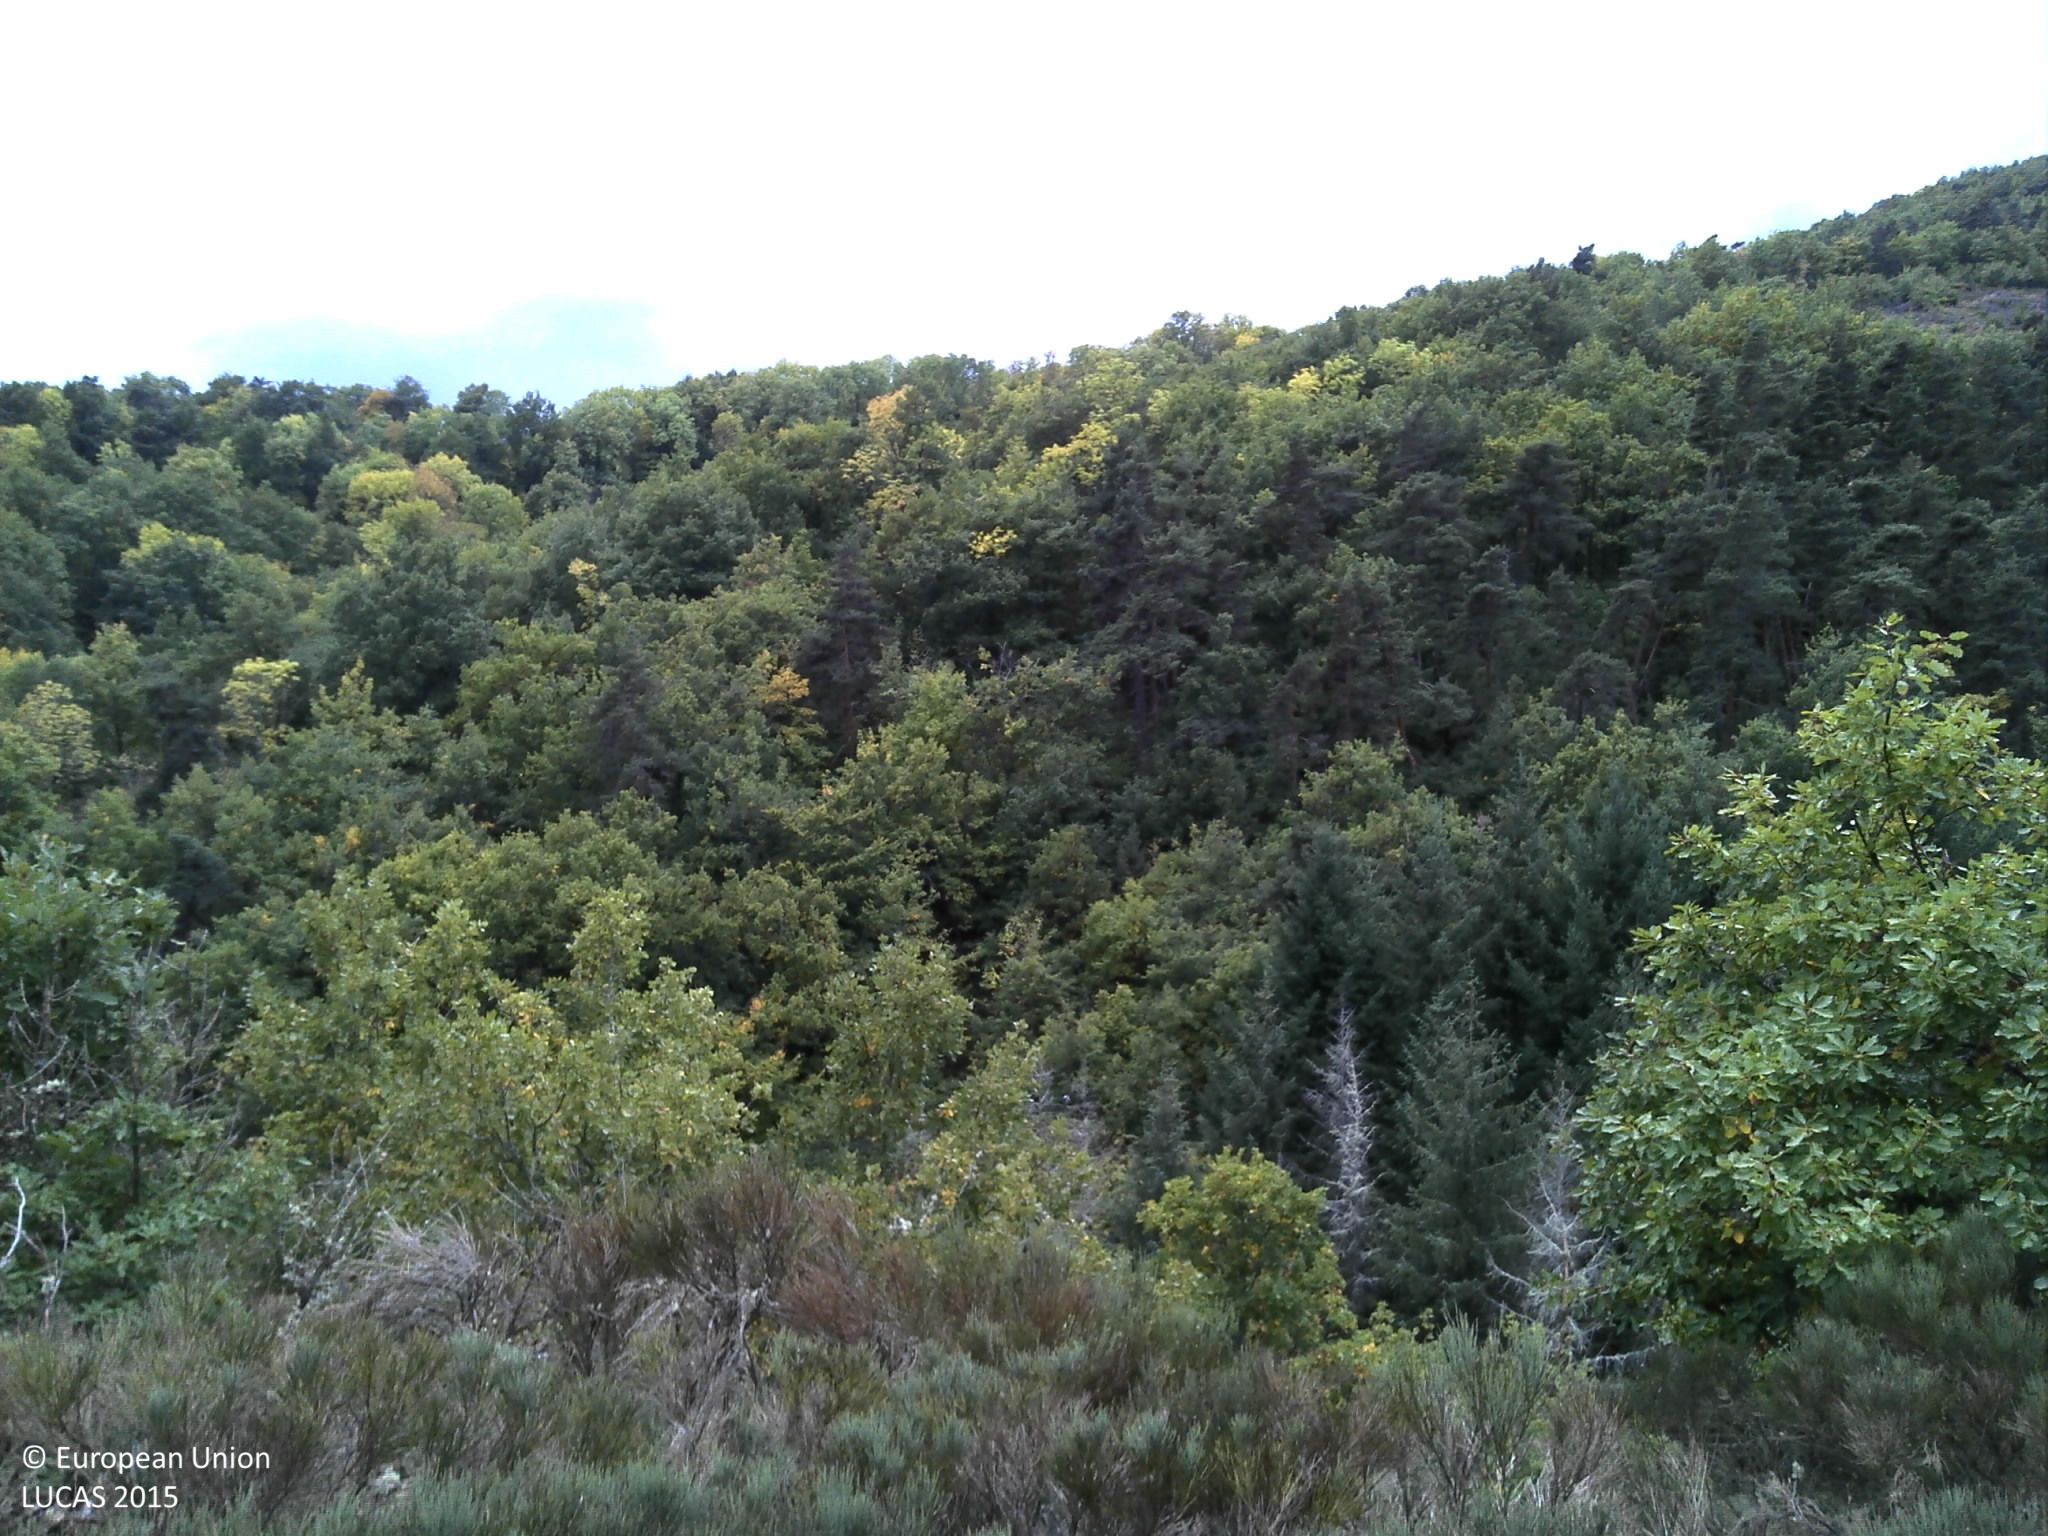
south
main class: Woodland
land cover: Pine dominated mixed woodland
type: alpine coniferous forest
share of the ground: > 75 %
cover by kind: coniferous forest trees 50 %, broadleaved forest trees 25 %, herbaceous plants 15 %, unconsolidated bare surface 10 %
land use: Forestry
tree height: > 5 m
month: October
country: FR
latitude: 45.4061
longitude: 3.1145
